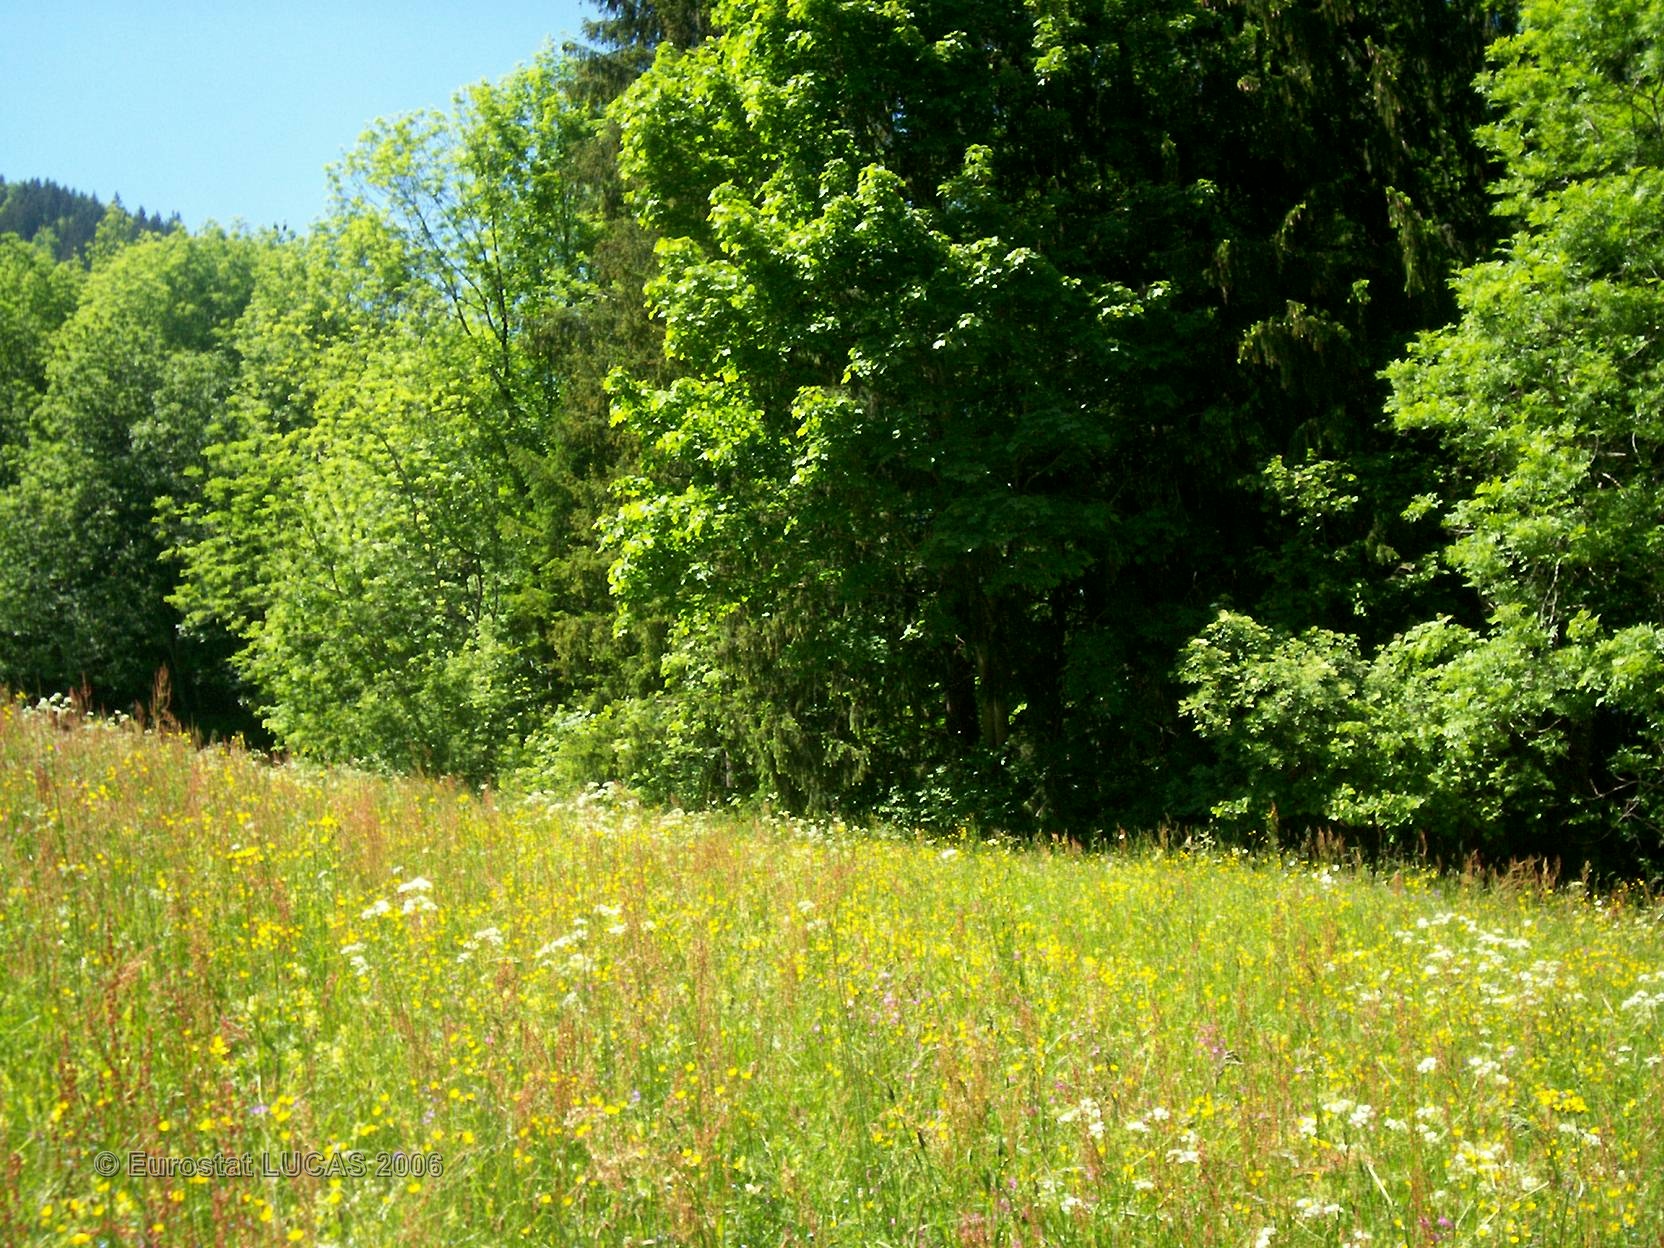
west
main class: Grassland
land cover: Grassland without tree/shrub cover
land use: Agriculture (excluding fallow land and kitchen gardens)
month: June
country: FR
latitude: 46.3173
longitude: 6.6656
